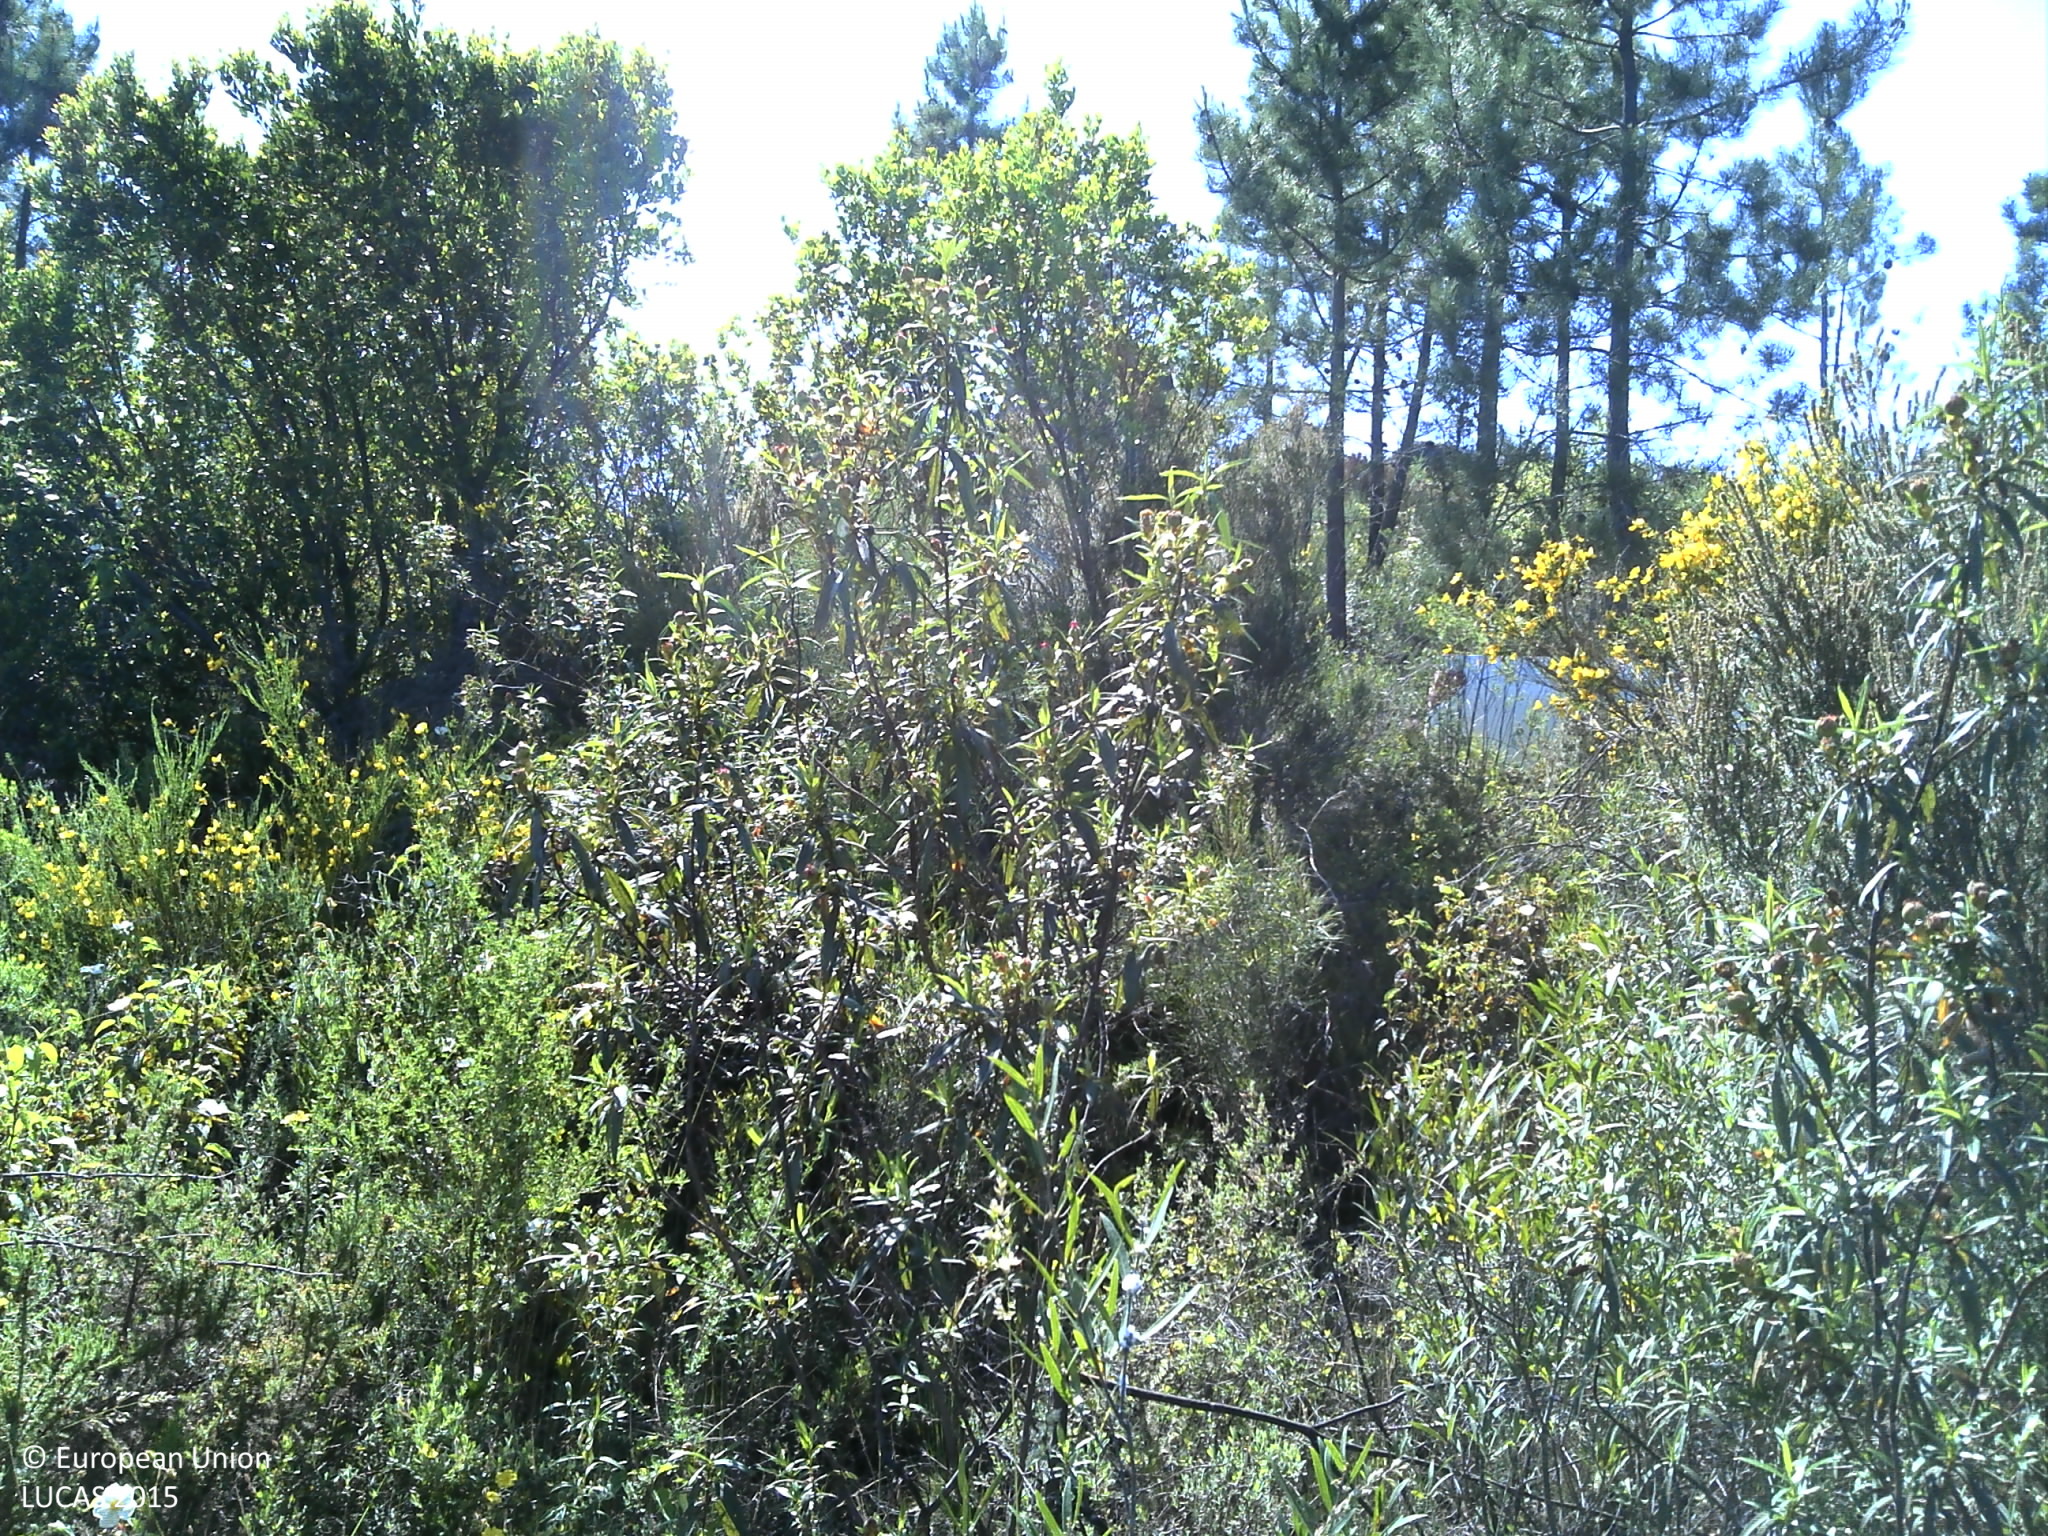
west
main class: Shrubland
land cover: Shrubland with sparse tree cover
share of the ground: > 75 %
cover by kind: shrubs 95 %, coniferous forest trees 5 %
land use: Forestry
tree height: > 5 m
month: May
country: PT
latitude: 41.5986
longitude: -7.5877
